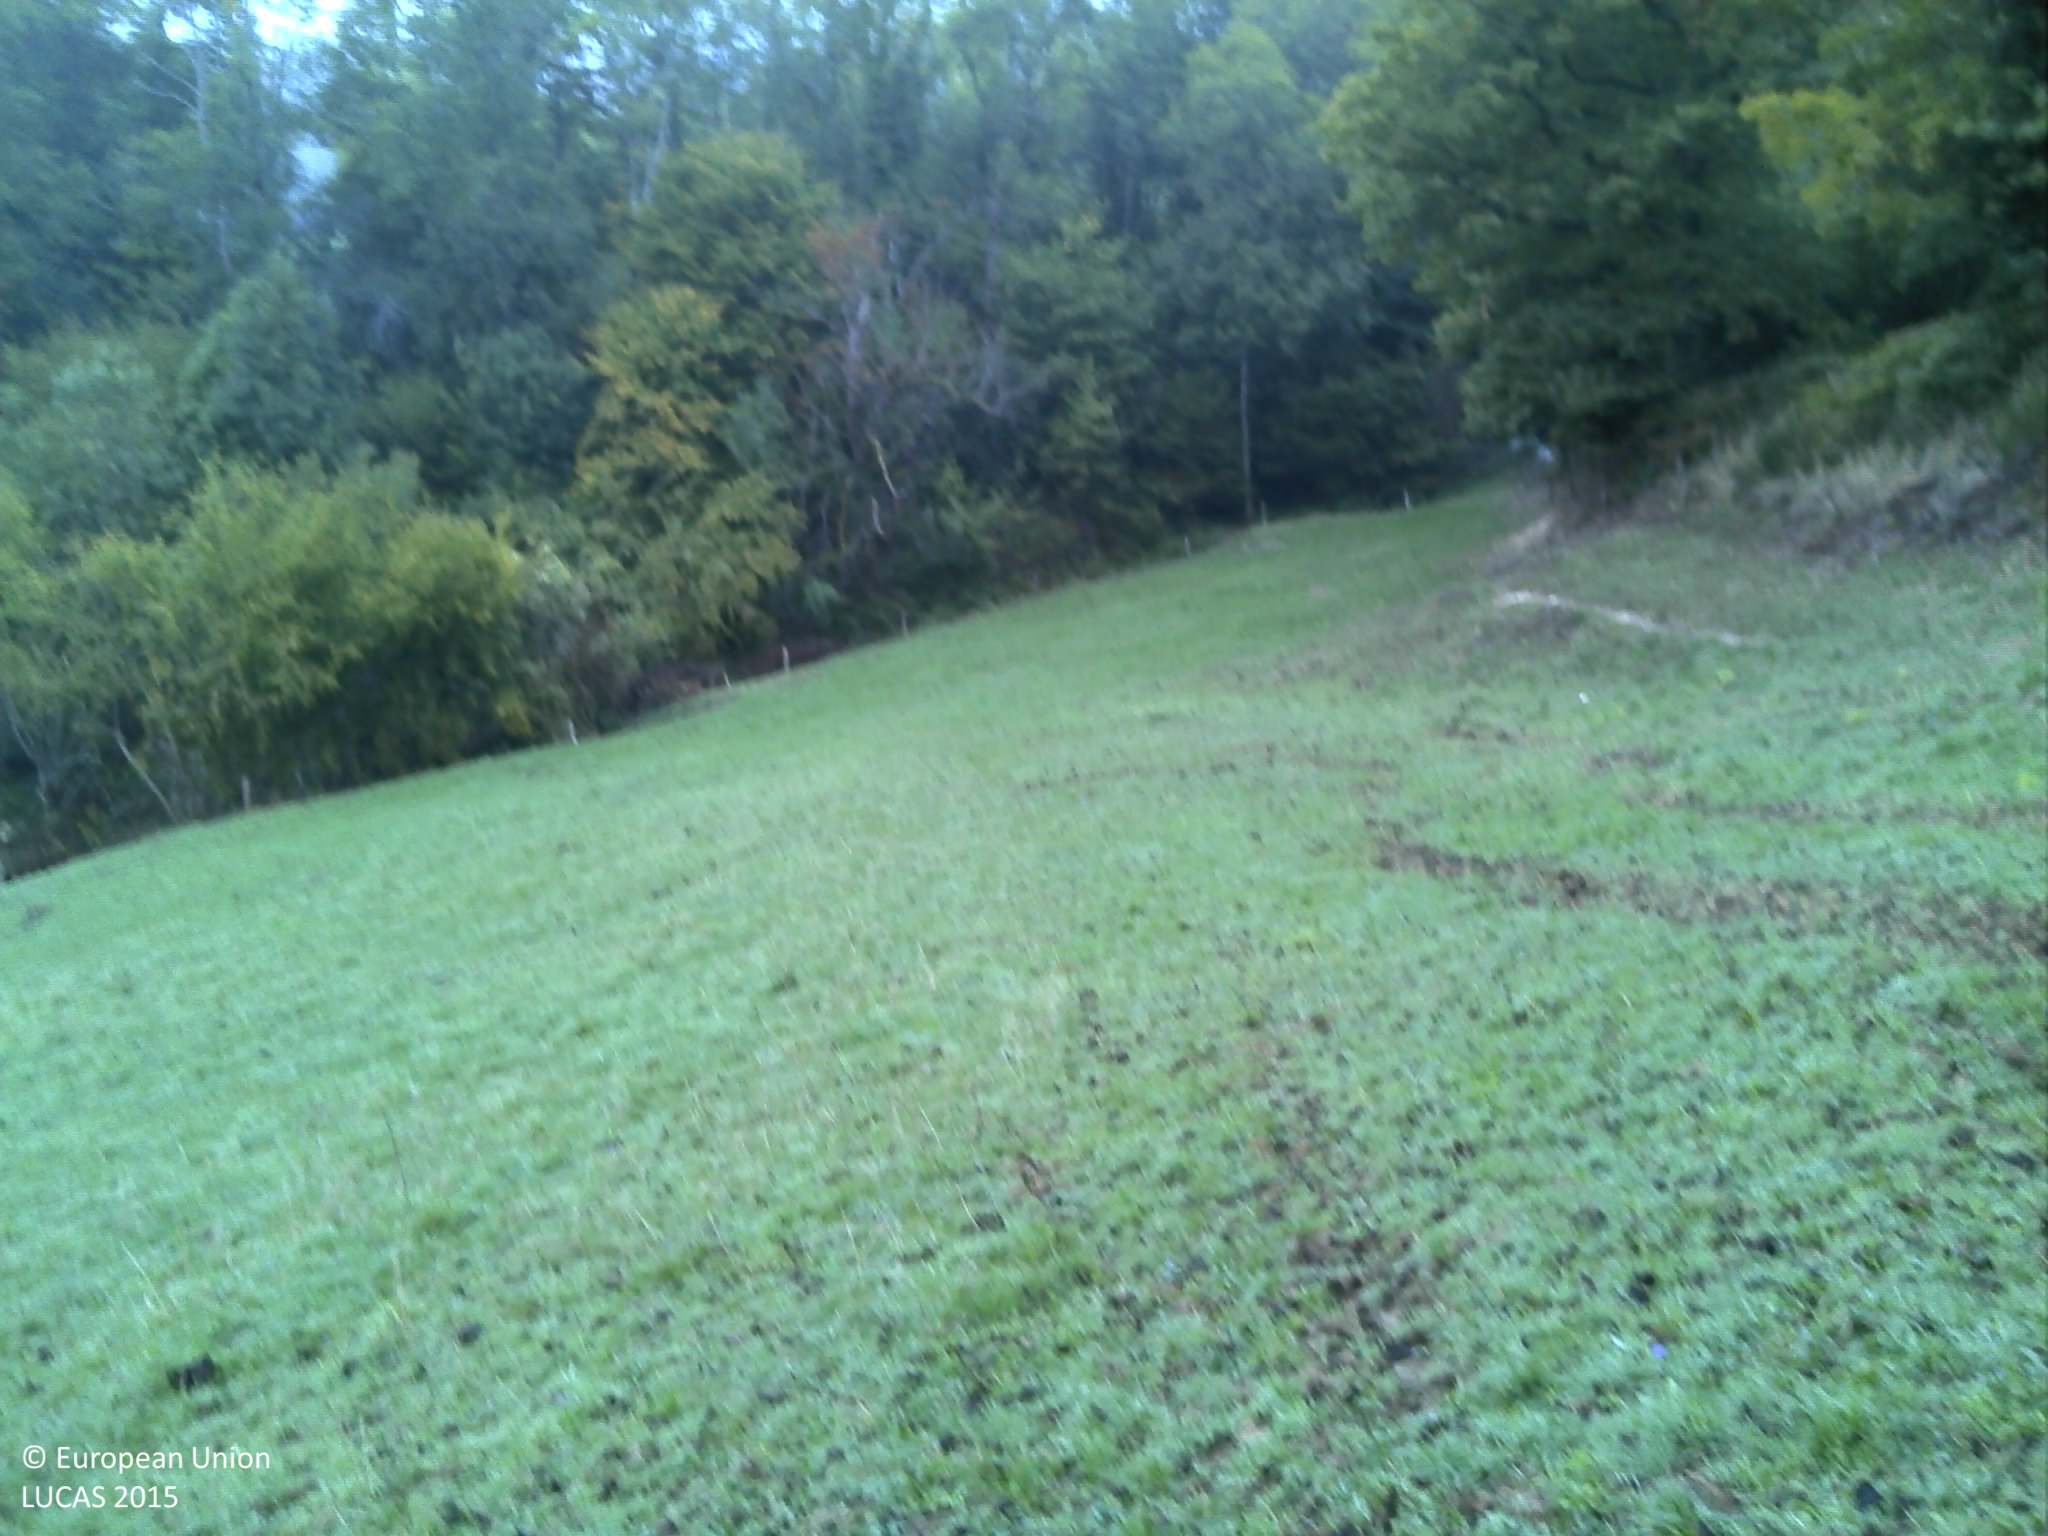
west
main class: Grassland
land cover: Grassland without tree/shrub cover
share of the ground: > 75 %
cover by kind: herbaceous plants 100 %
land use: Agriculture (excluding fallow land and kitchen gardens)
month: October
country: FR
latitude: 46.7809
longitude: 4.0401
